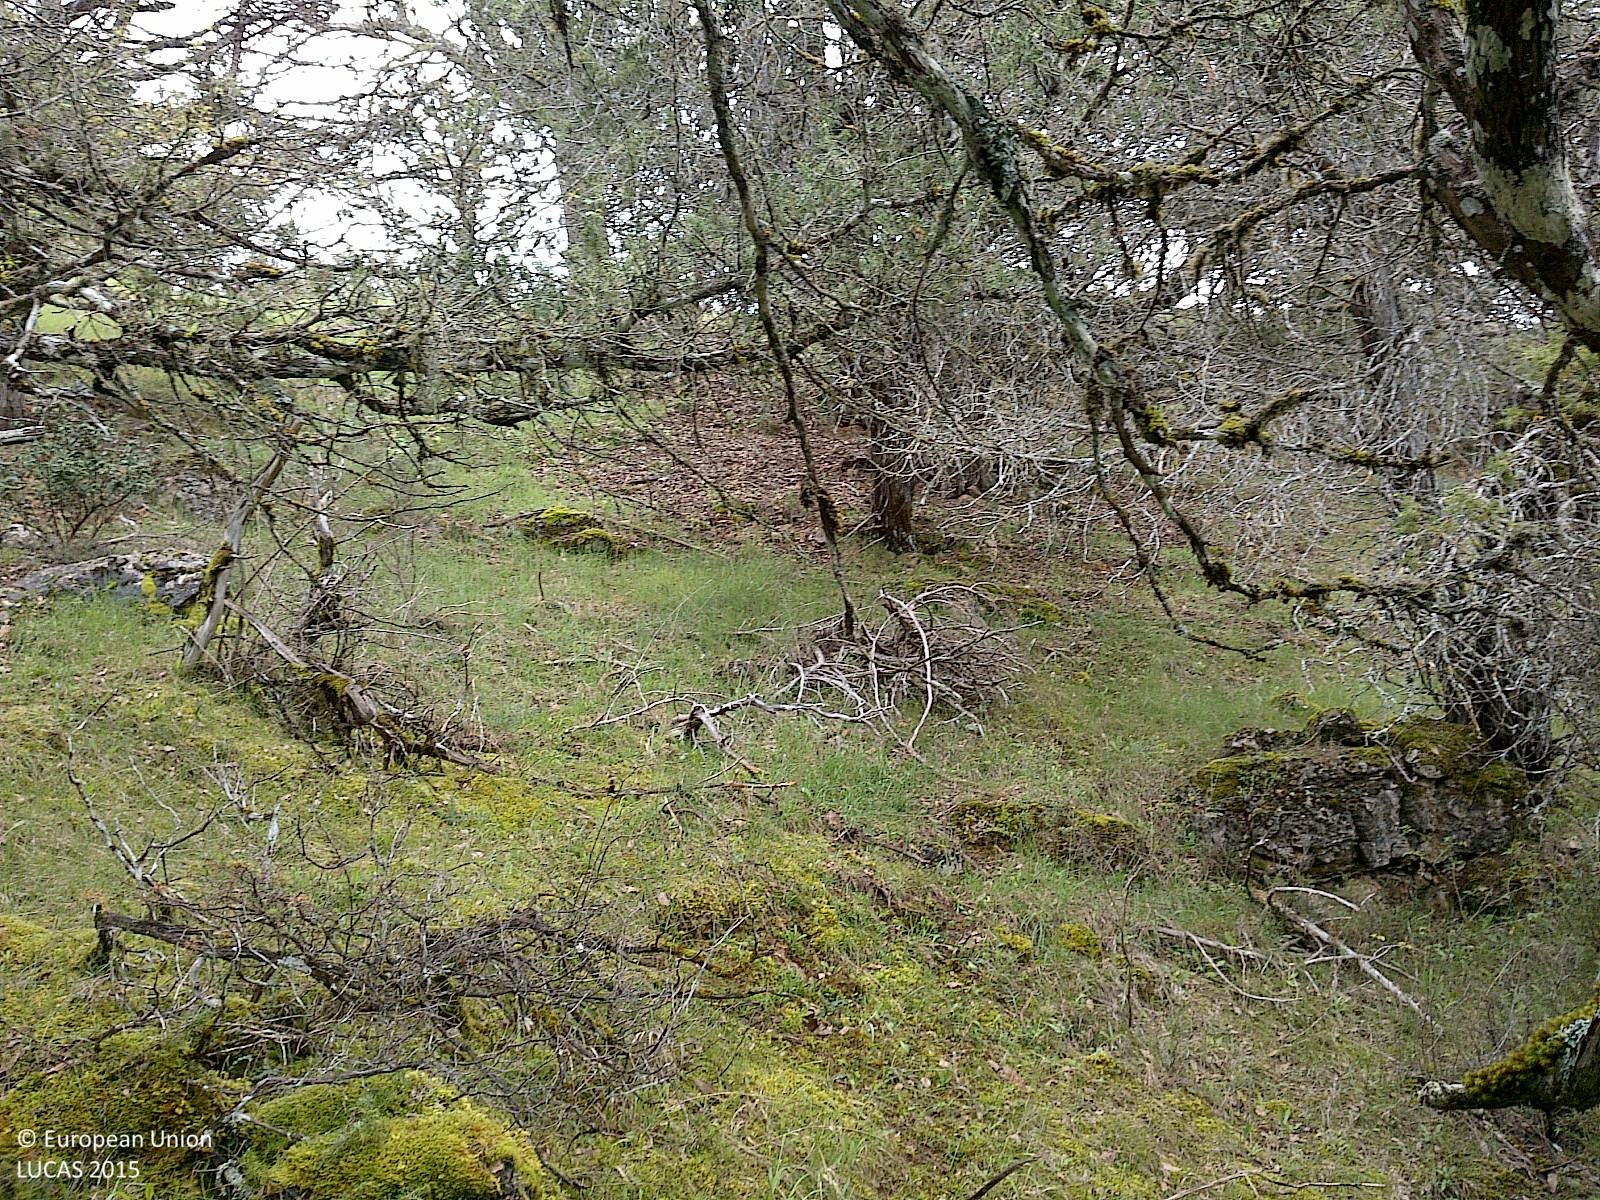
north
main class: Woodland
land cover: Other coniferous woodland
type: coniferous forest of the mediterranean region
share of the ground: 50 - 75 %
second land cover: Grassland without tree/shrub cover
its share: > 75 %
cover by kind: coniferous forest trees 55 %, herbaceous plants 40 %, shrubs 5 %
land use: Forestry
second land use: Agriculture (excluding fallow land and kitchen gardens)
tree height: > 5 m
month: May
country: ES
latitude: 41.9491
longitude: -3.2101
